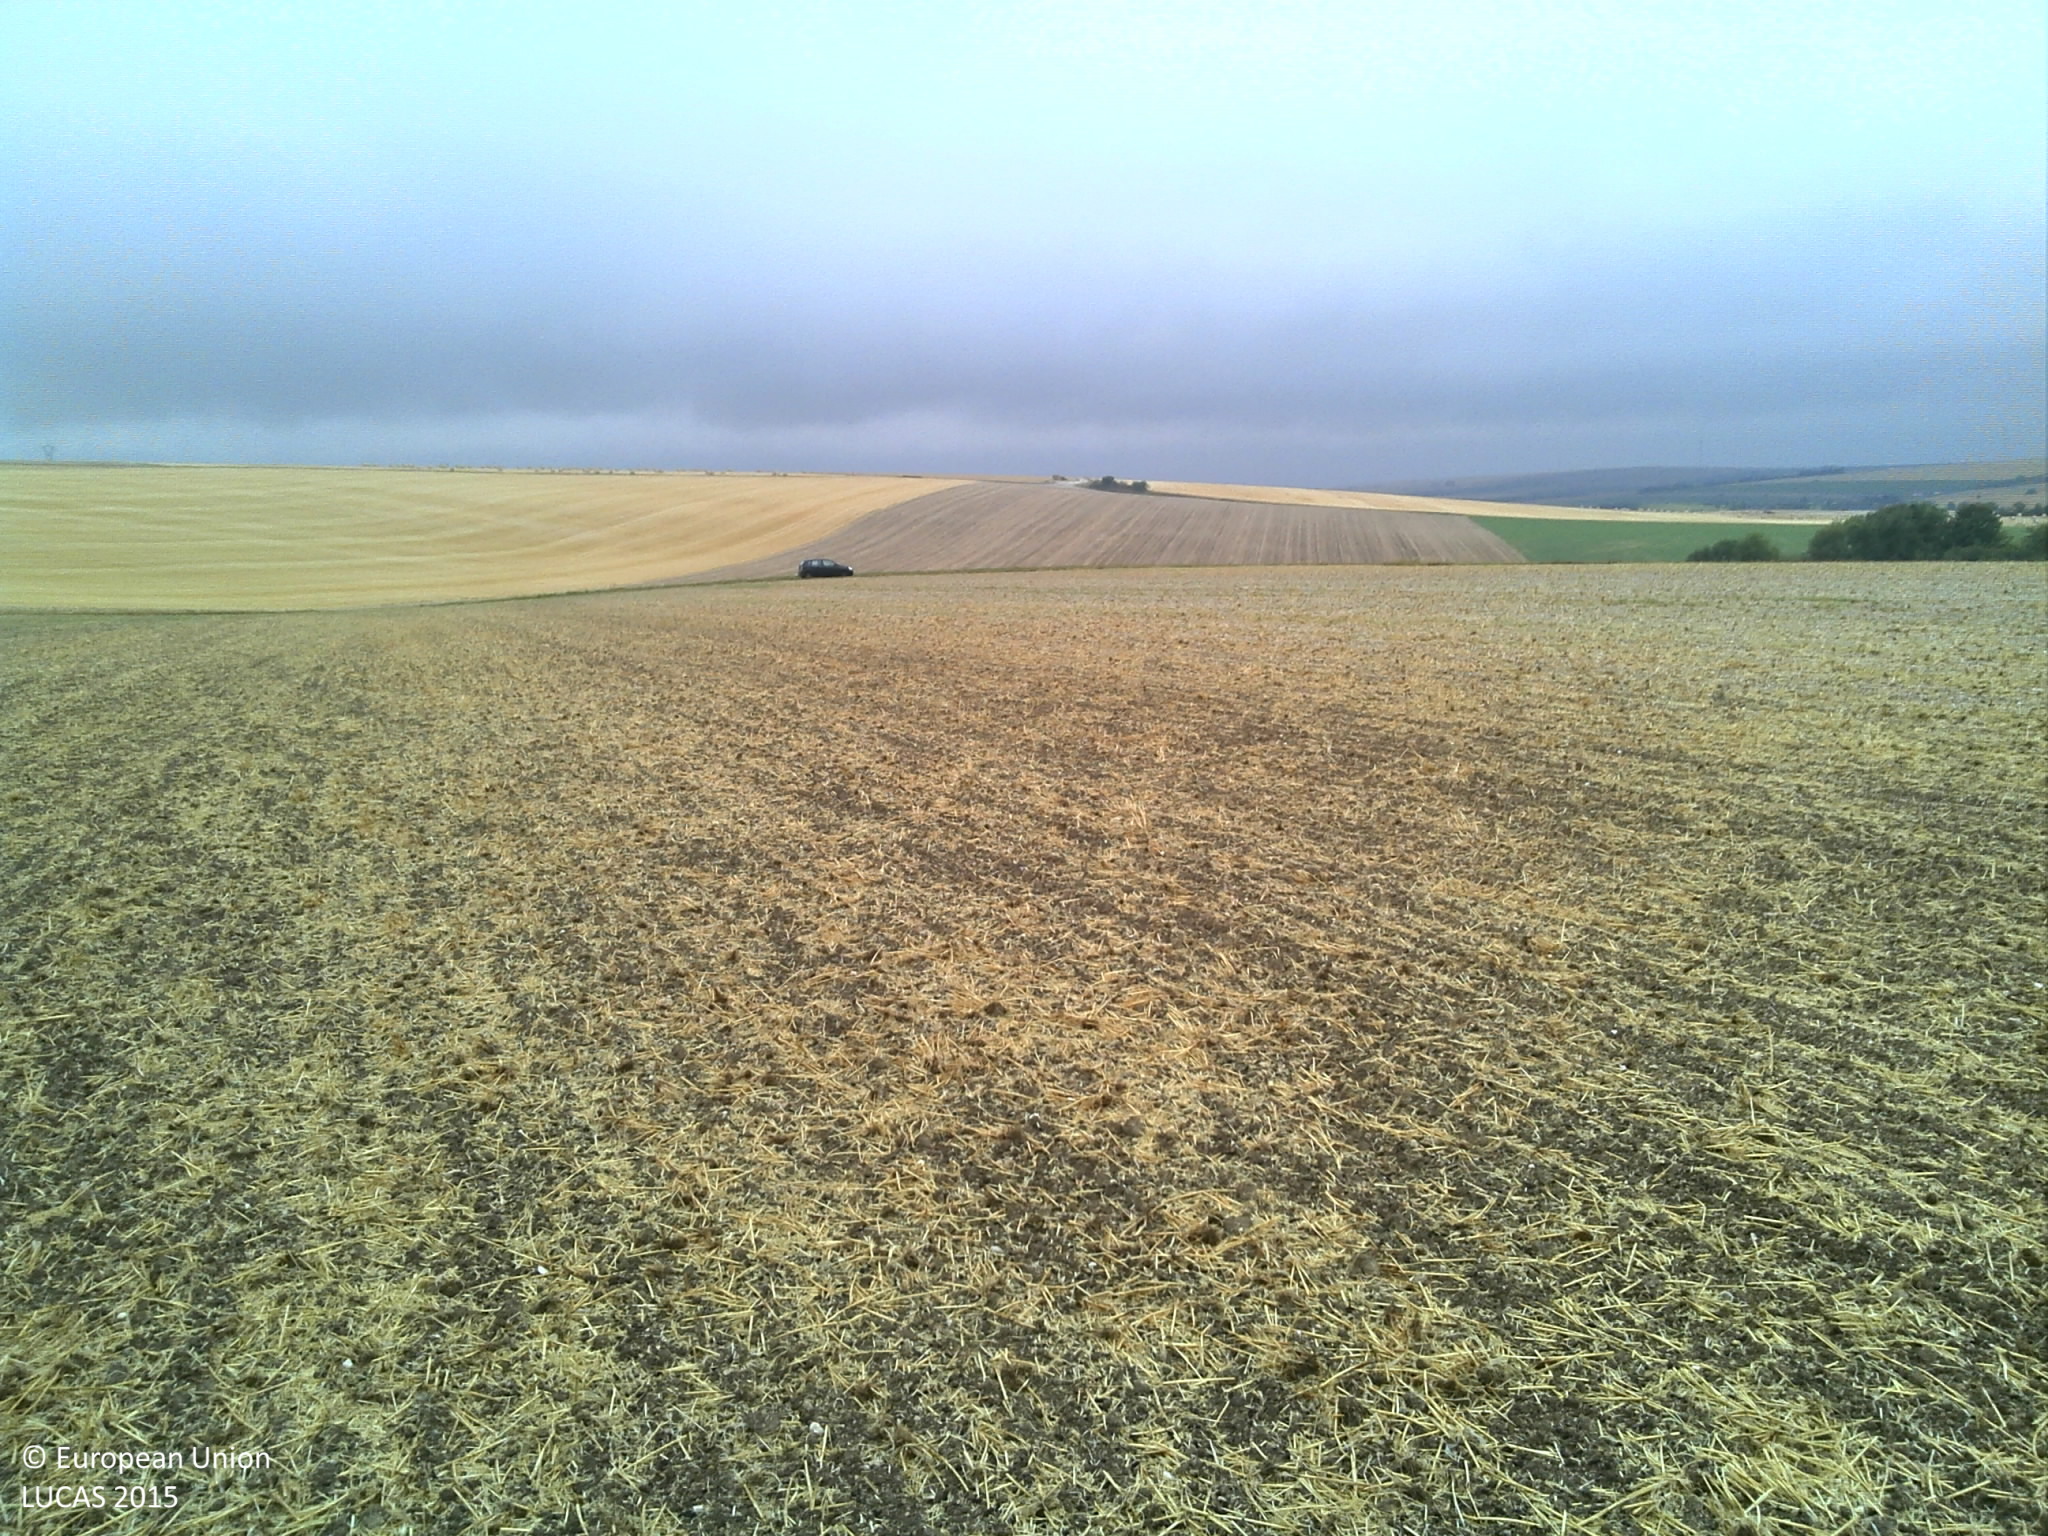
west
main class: Cropland
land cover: Common wheat
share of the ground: > 75 %
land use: Agriculture (excluding fallow land and kitchen gardens)
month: August
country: FR
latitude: 48.8326
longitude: 4.6433
